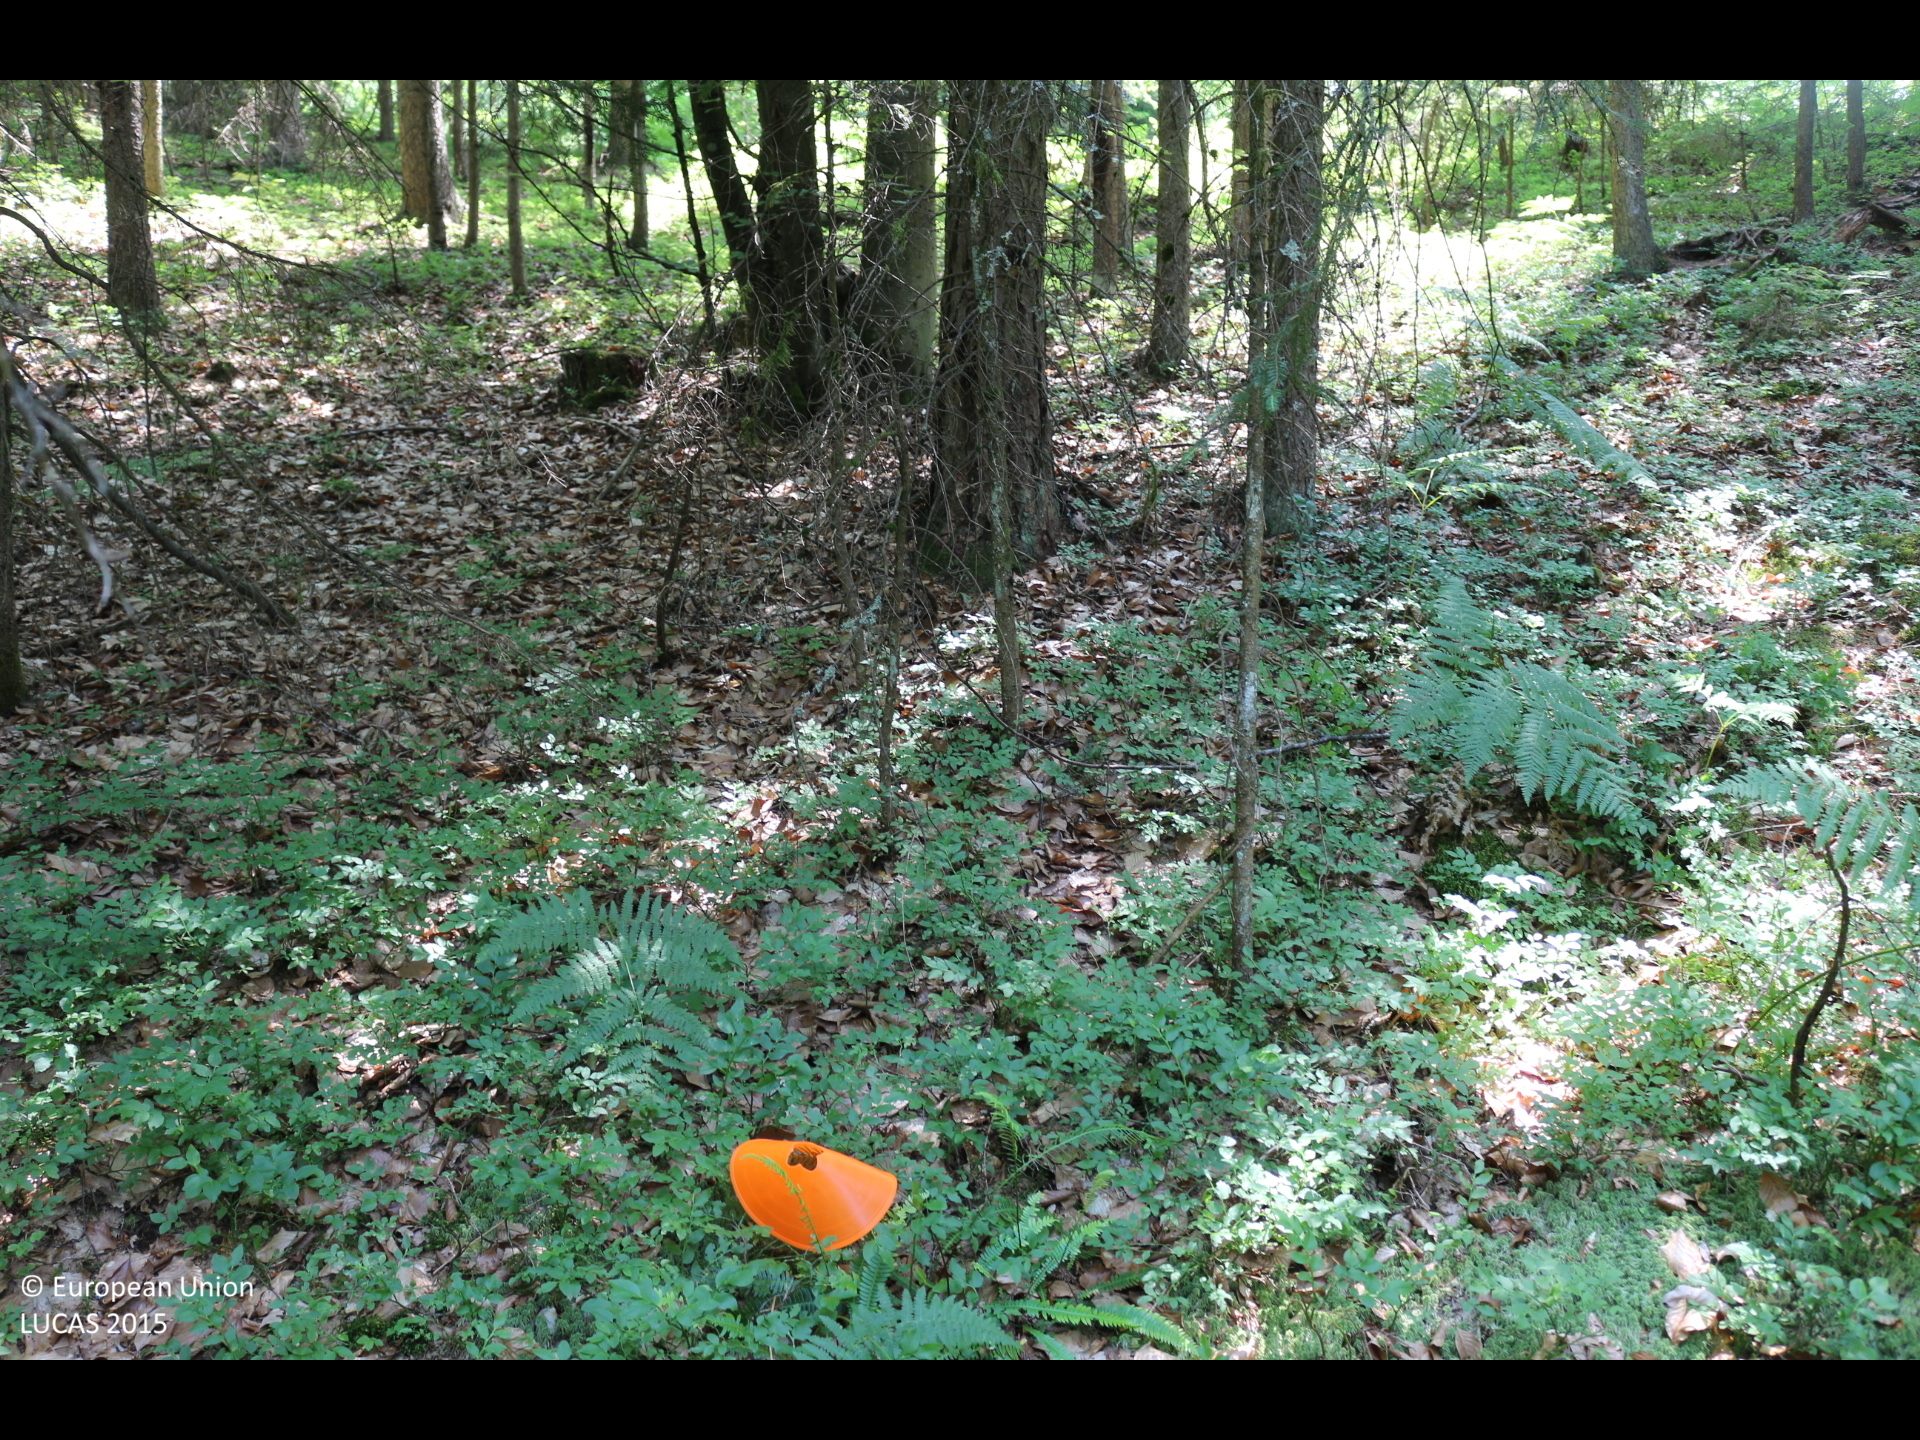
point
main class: Woodland
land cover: Spruce dominated mixed woodland
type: alpine coniferous forest
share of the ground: > 75 %
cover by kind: coniferous forest trees 70 %, broadleaved forest trees 30 %
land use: Forestry
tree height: > 5 m
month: June
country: AT
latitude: 46.5658
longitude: 13.9762
